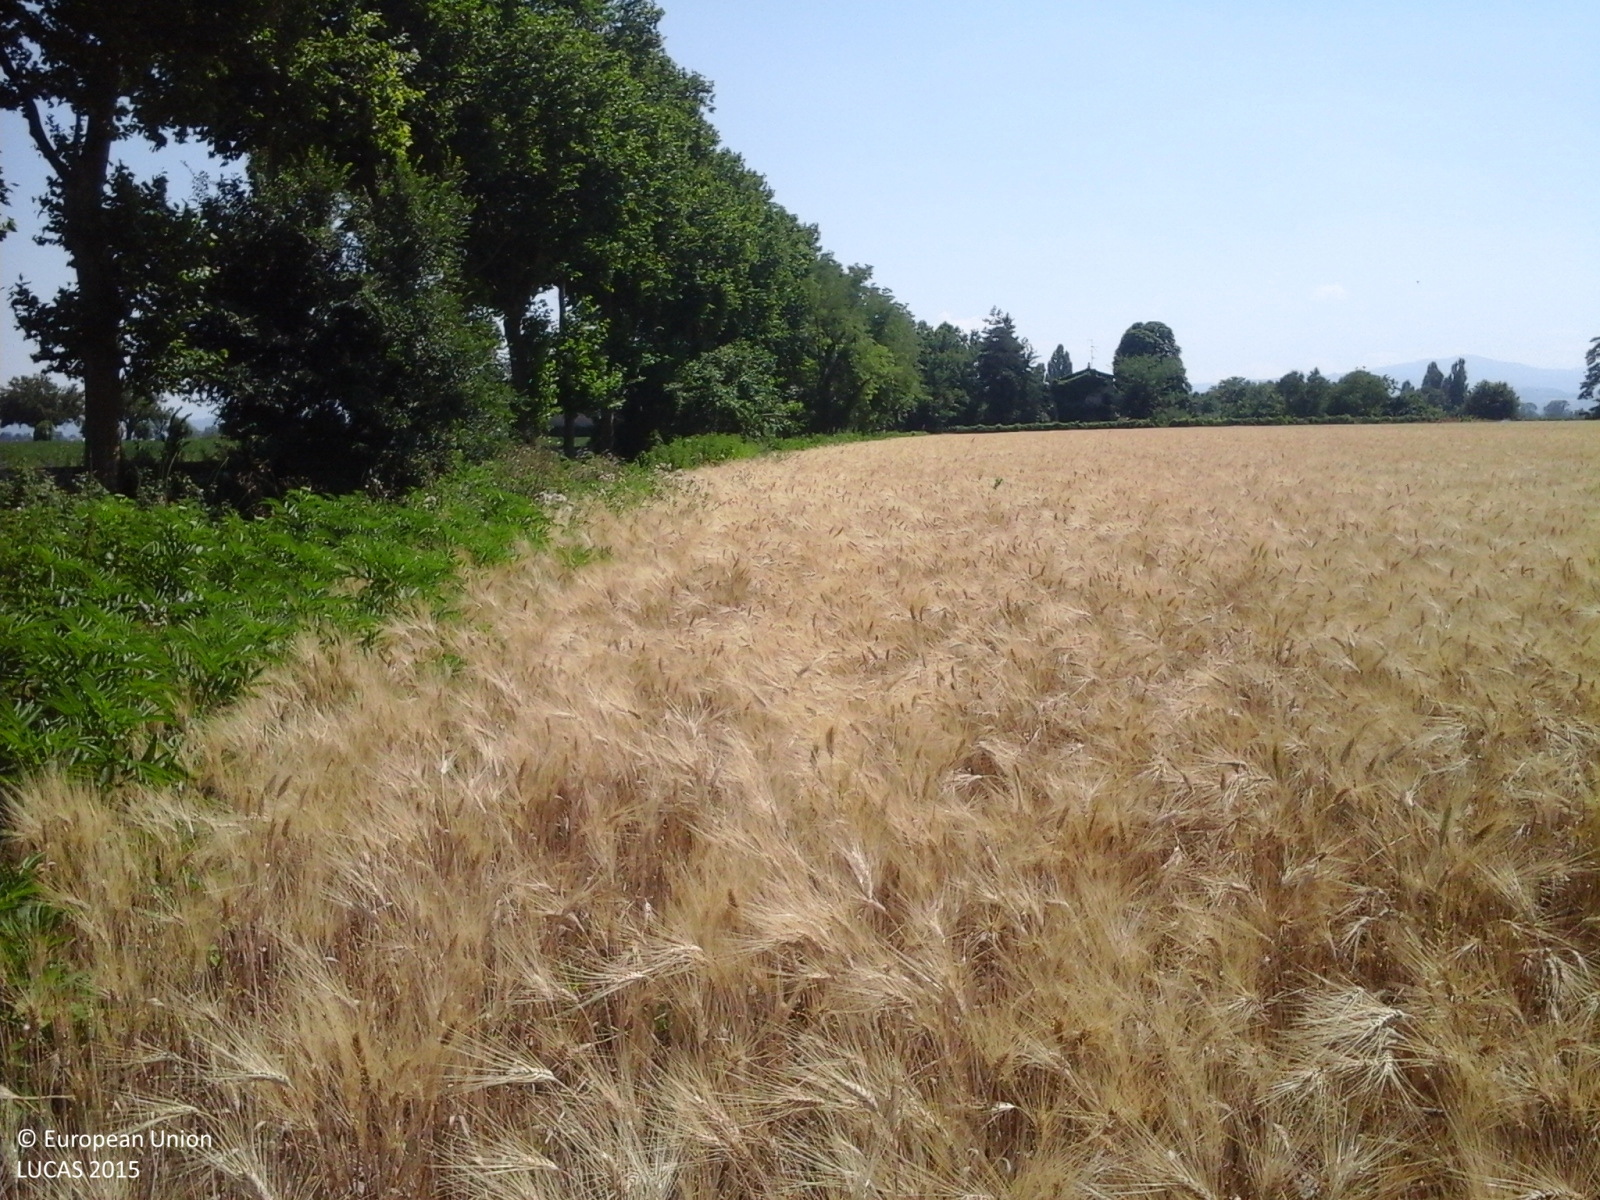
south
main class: Cropland
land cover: Barley
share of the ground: > 75 %
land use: Agriculture (excluding fallow land and kitchen gardens)
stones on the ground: < 10 %
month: June
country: IT
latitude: 44.7468
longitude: 10.3151
